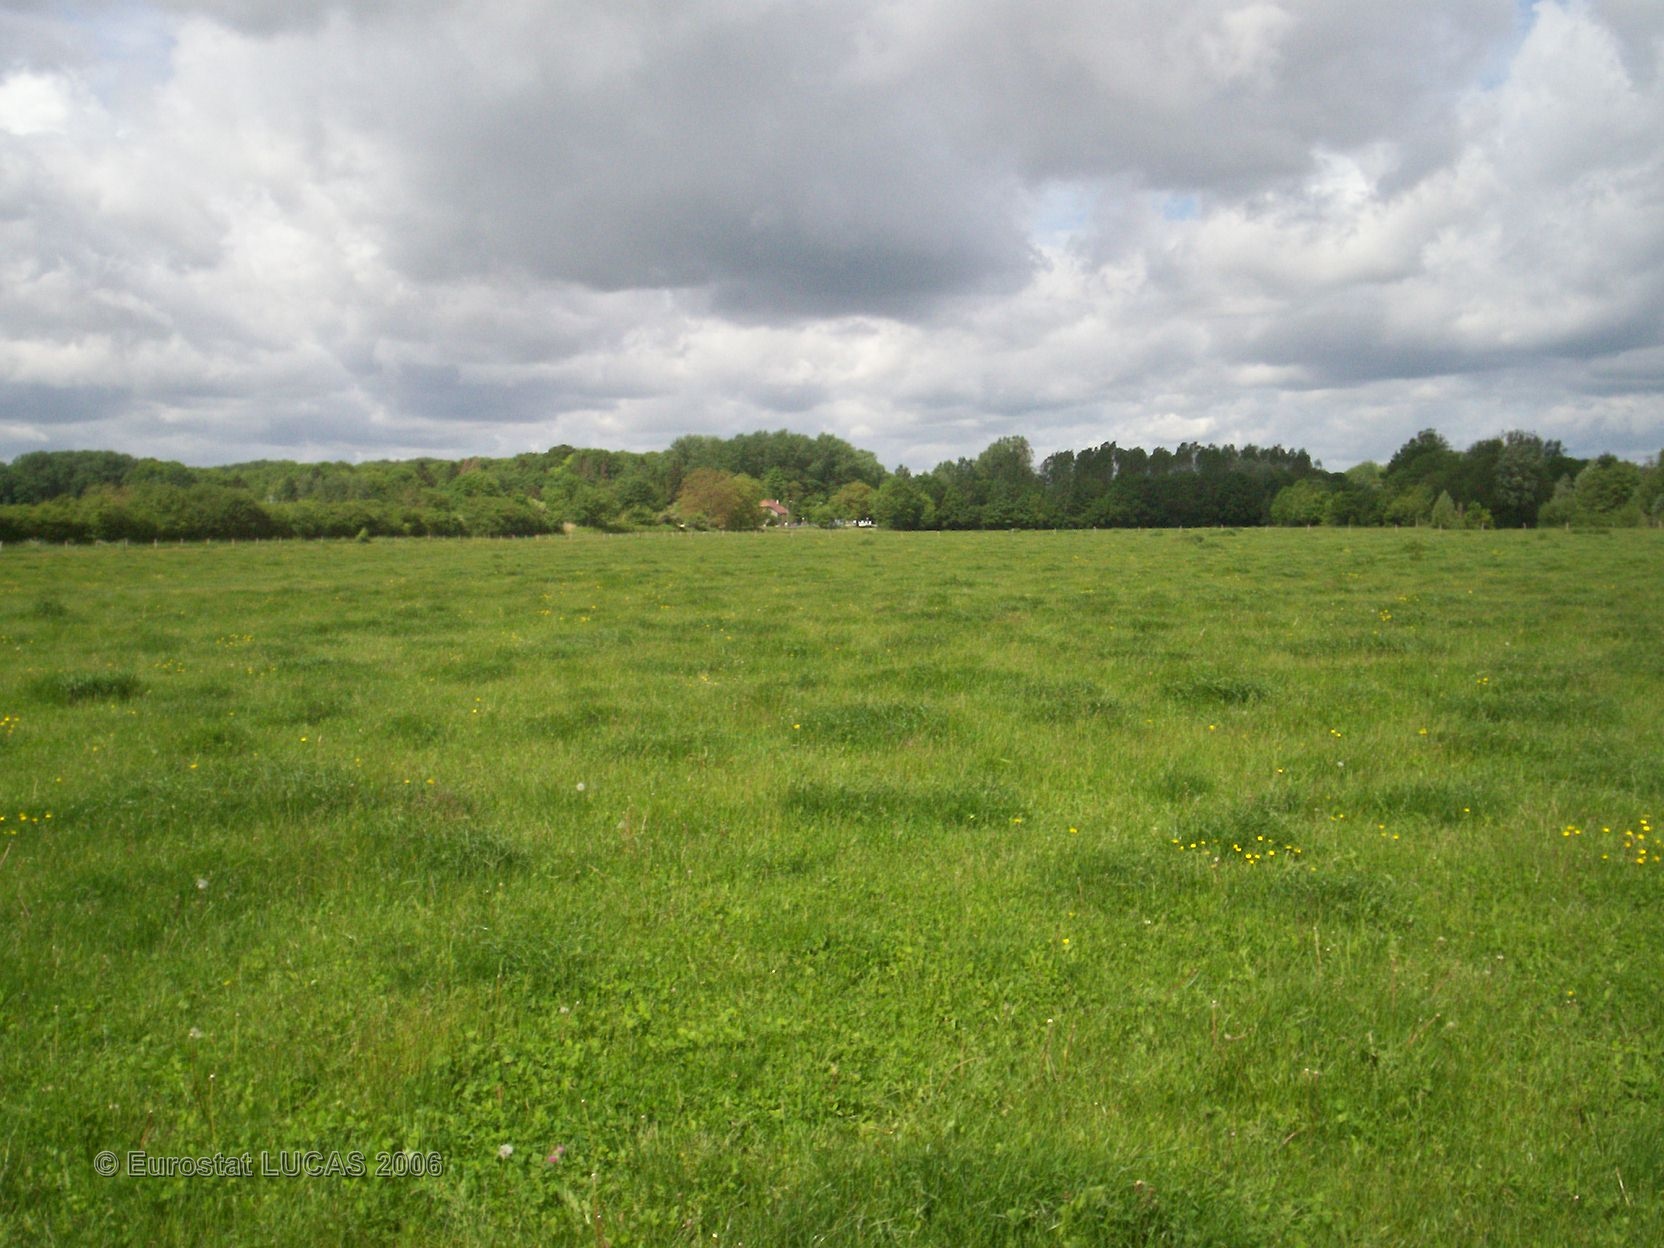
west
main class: Grassland
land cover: Grassland without tree/shrub cover
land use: Agriculture (excluding fallow land and kitchen gardens)
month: May
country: FR
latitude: 49.4894
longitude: 4.4327
